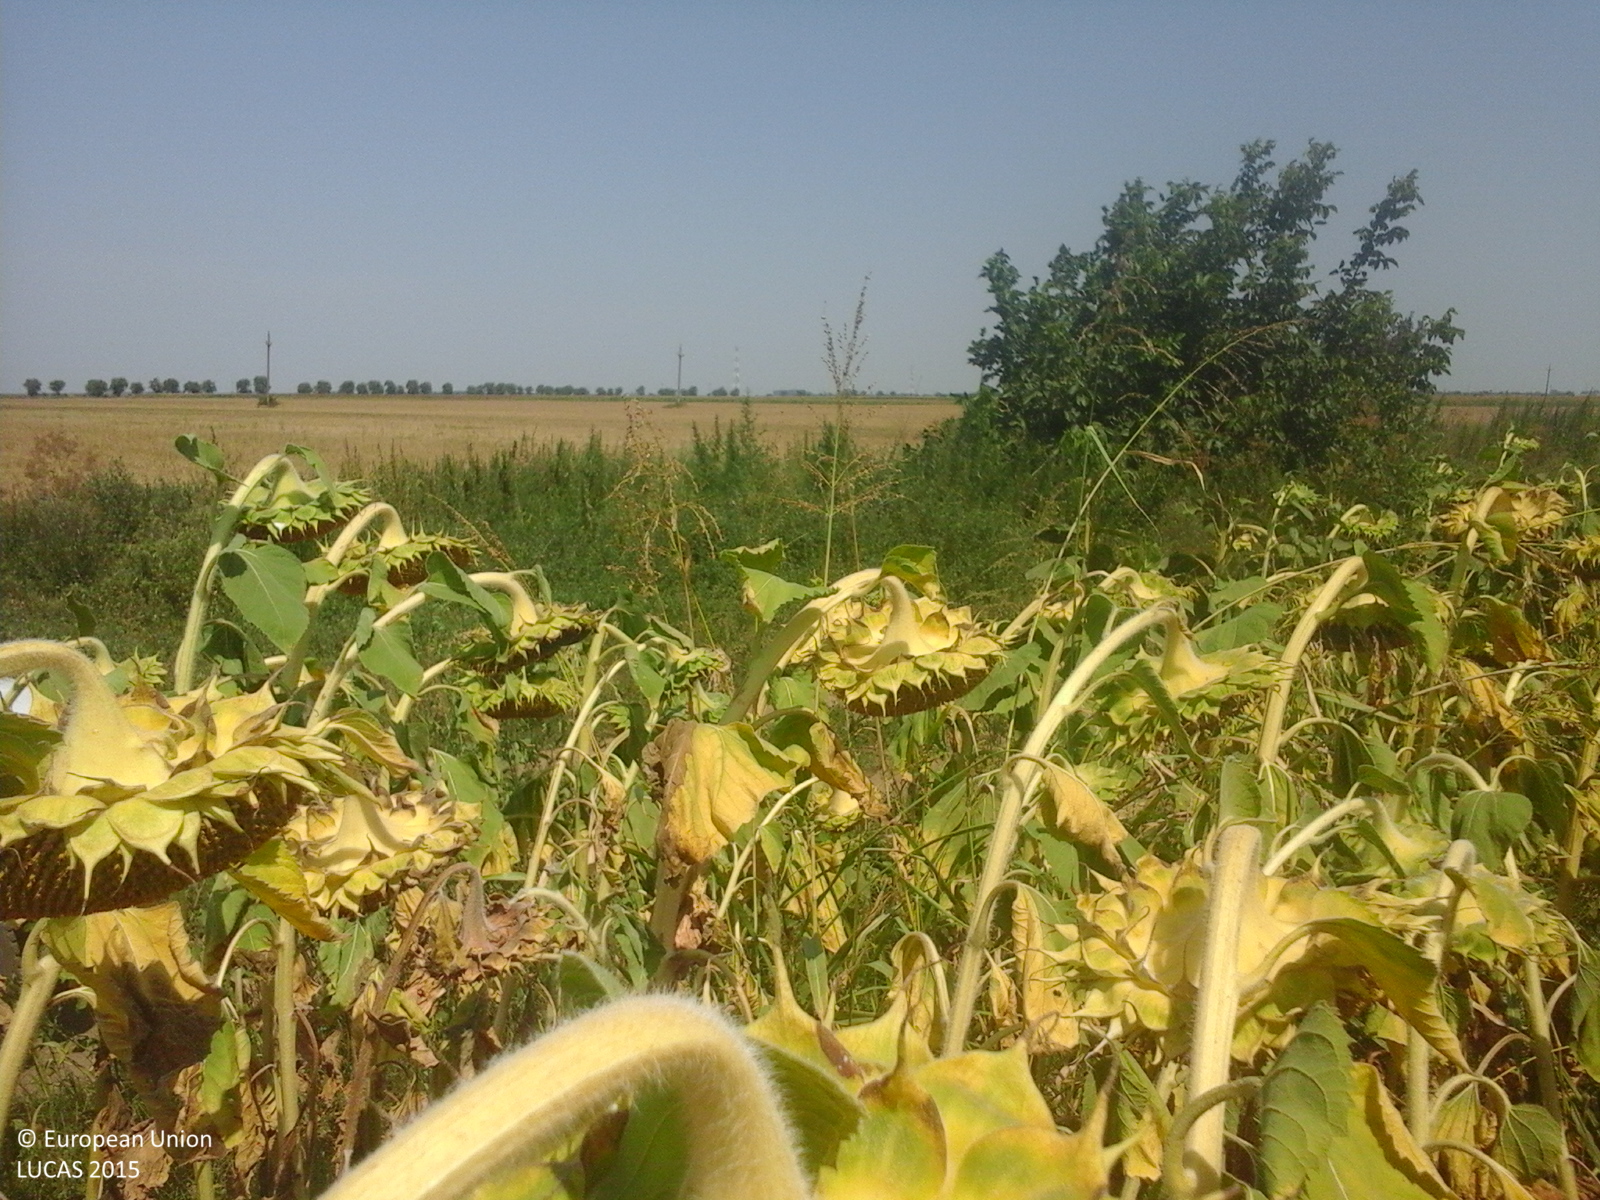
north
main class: Cropland
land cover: Sunflower
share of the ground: > 75 %
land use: Agriculture (excluding fallow land and kitchen gardens)
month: August
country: RO
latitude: 45.2163
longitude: 27.7697
